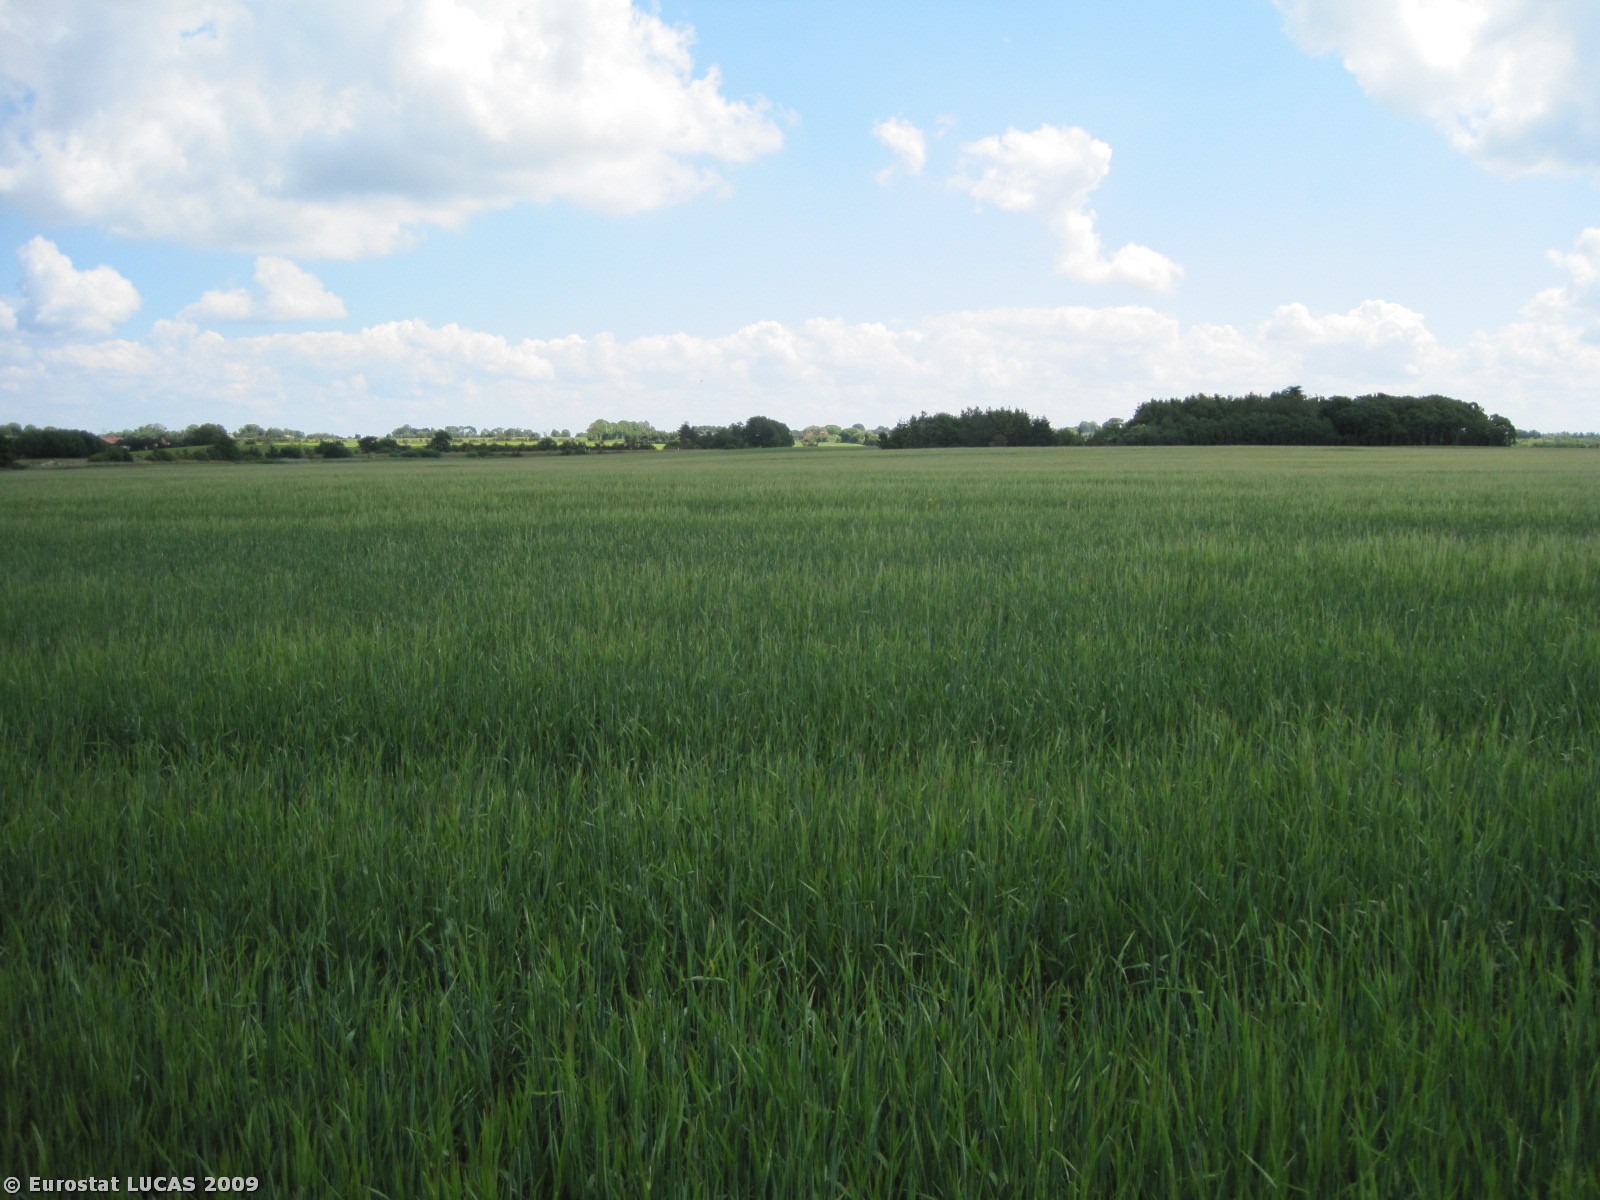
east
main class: Cropland
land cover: Barley
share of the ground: > 75 %
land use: Agriculture (excluding fallow land and kitchen gardens)
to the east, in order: Barley
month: June
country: DK
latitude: 56.6511
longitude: 8.9738
